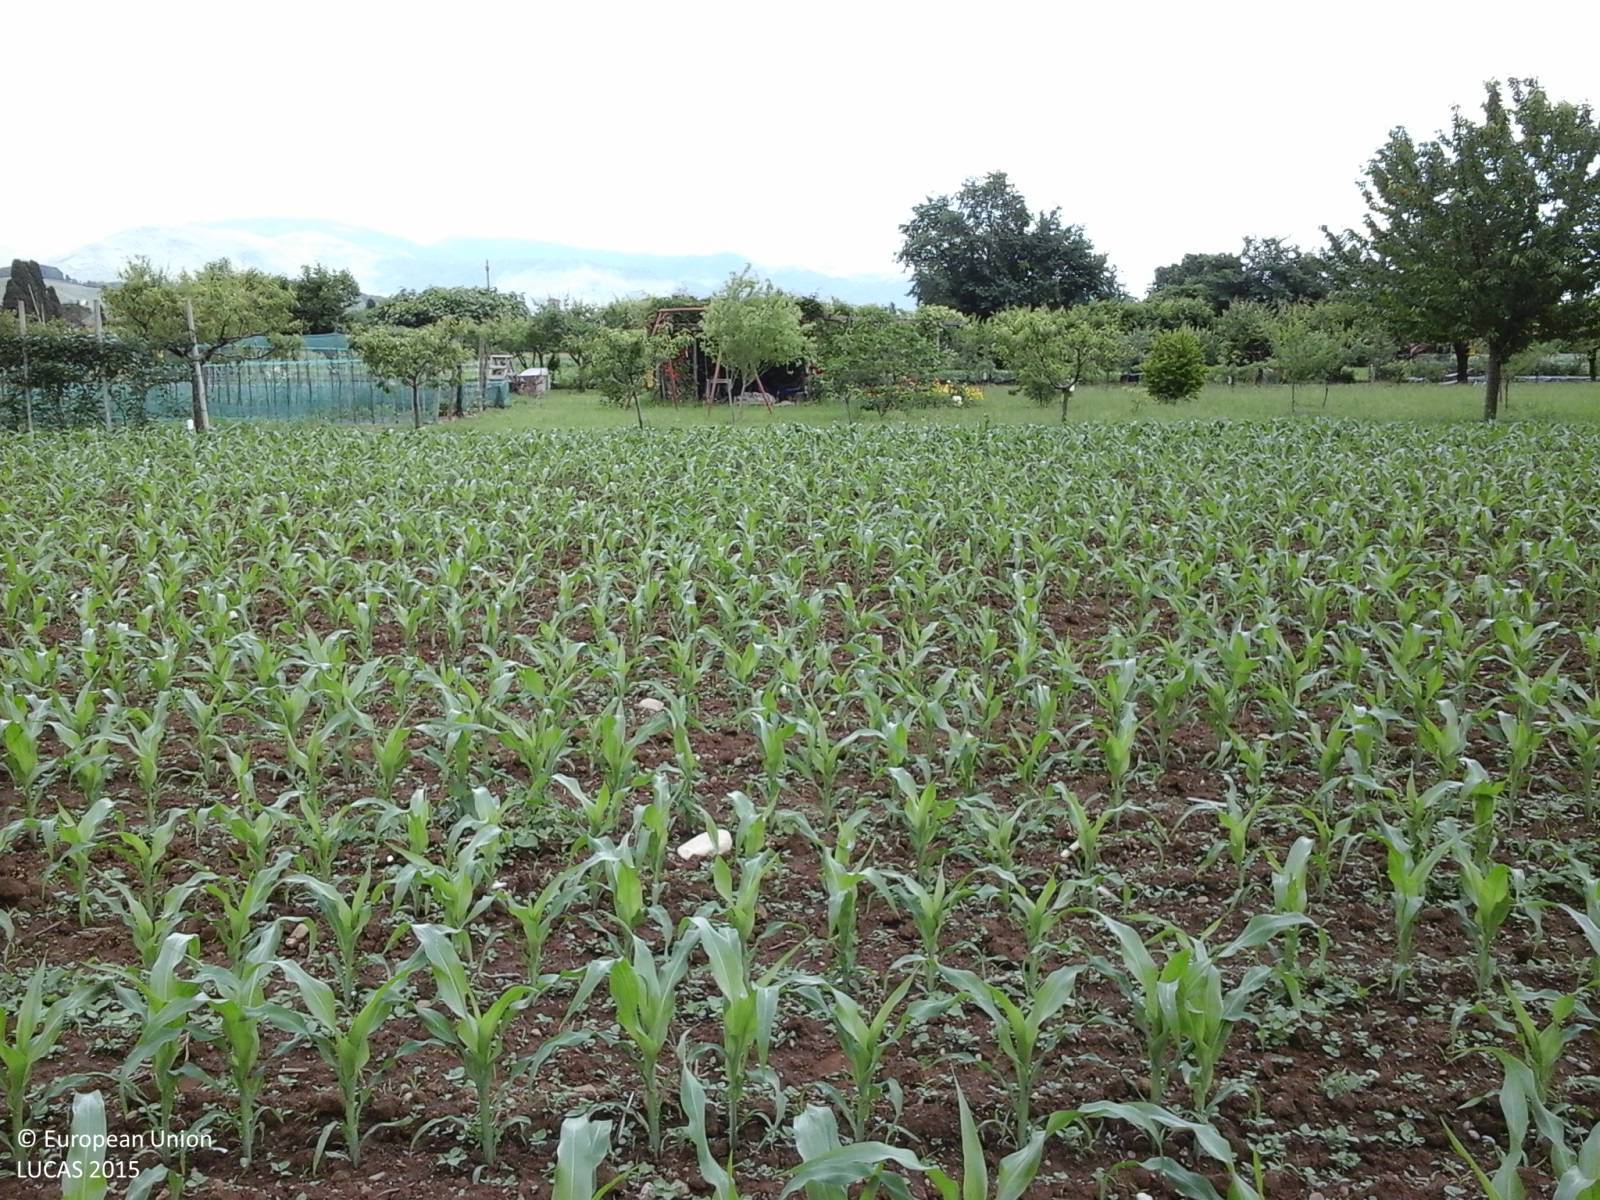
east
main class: Cropland
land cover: Maize
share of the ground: 10 - 25 %
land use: Agriculture (excluding fallow land and kitchen gardens)
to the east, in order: Maize; Grassland with sparse tree/shrub cover; Other fruit trees and berries; Other fresh vegetables; Tracks; Maize; Grass margins; Maize; Temporary grasslands; Other bare soil
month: May
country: IT
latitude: 46.1577
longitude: 13.2468
